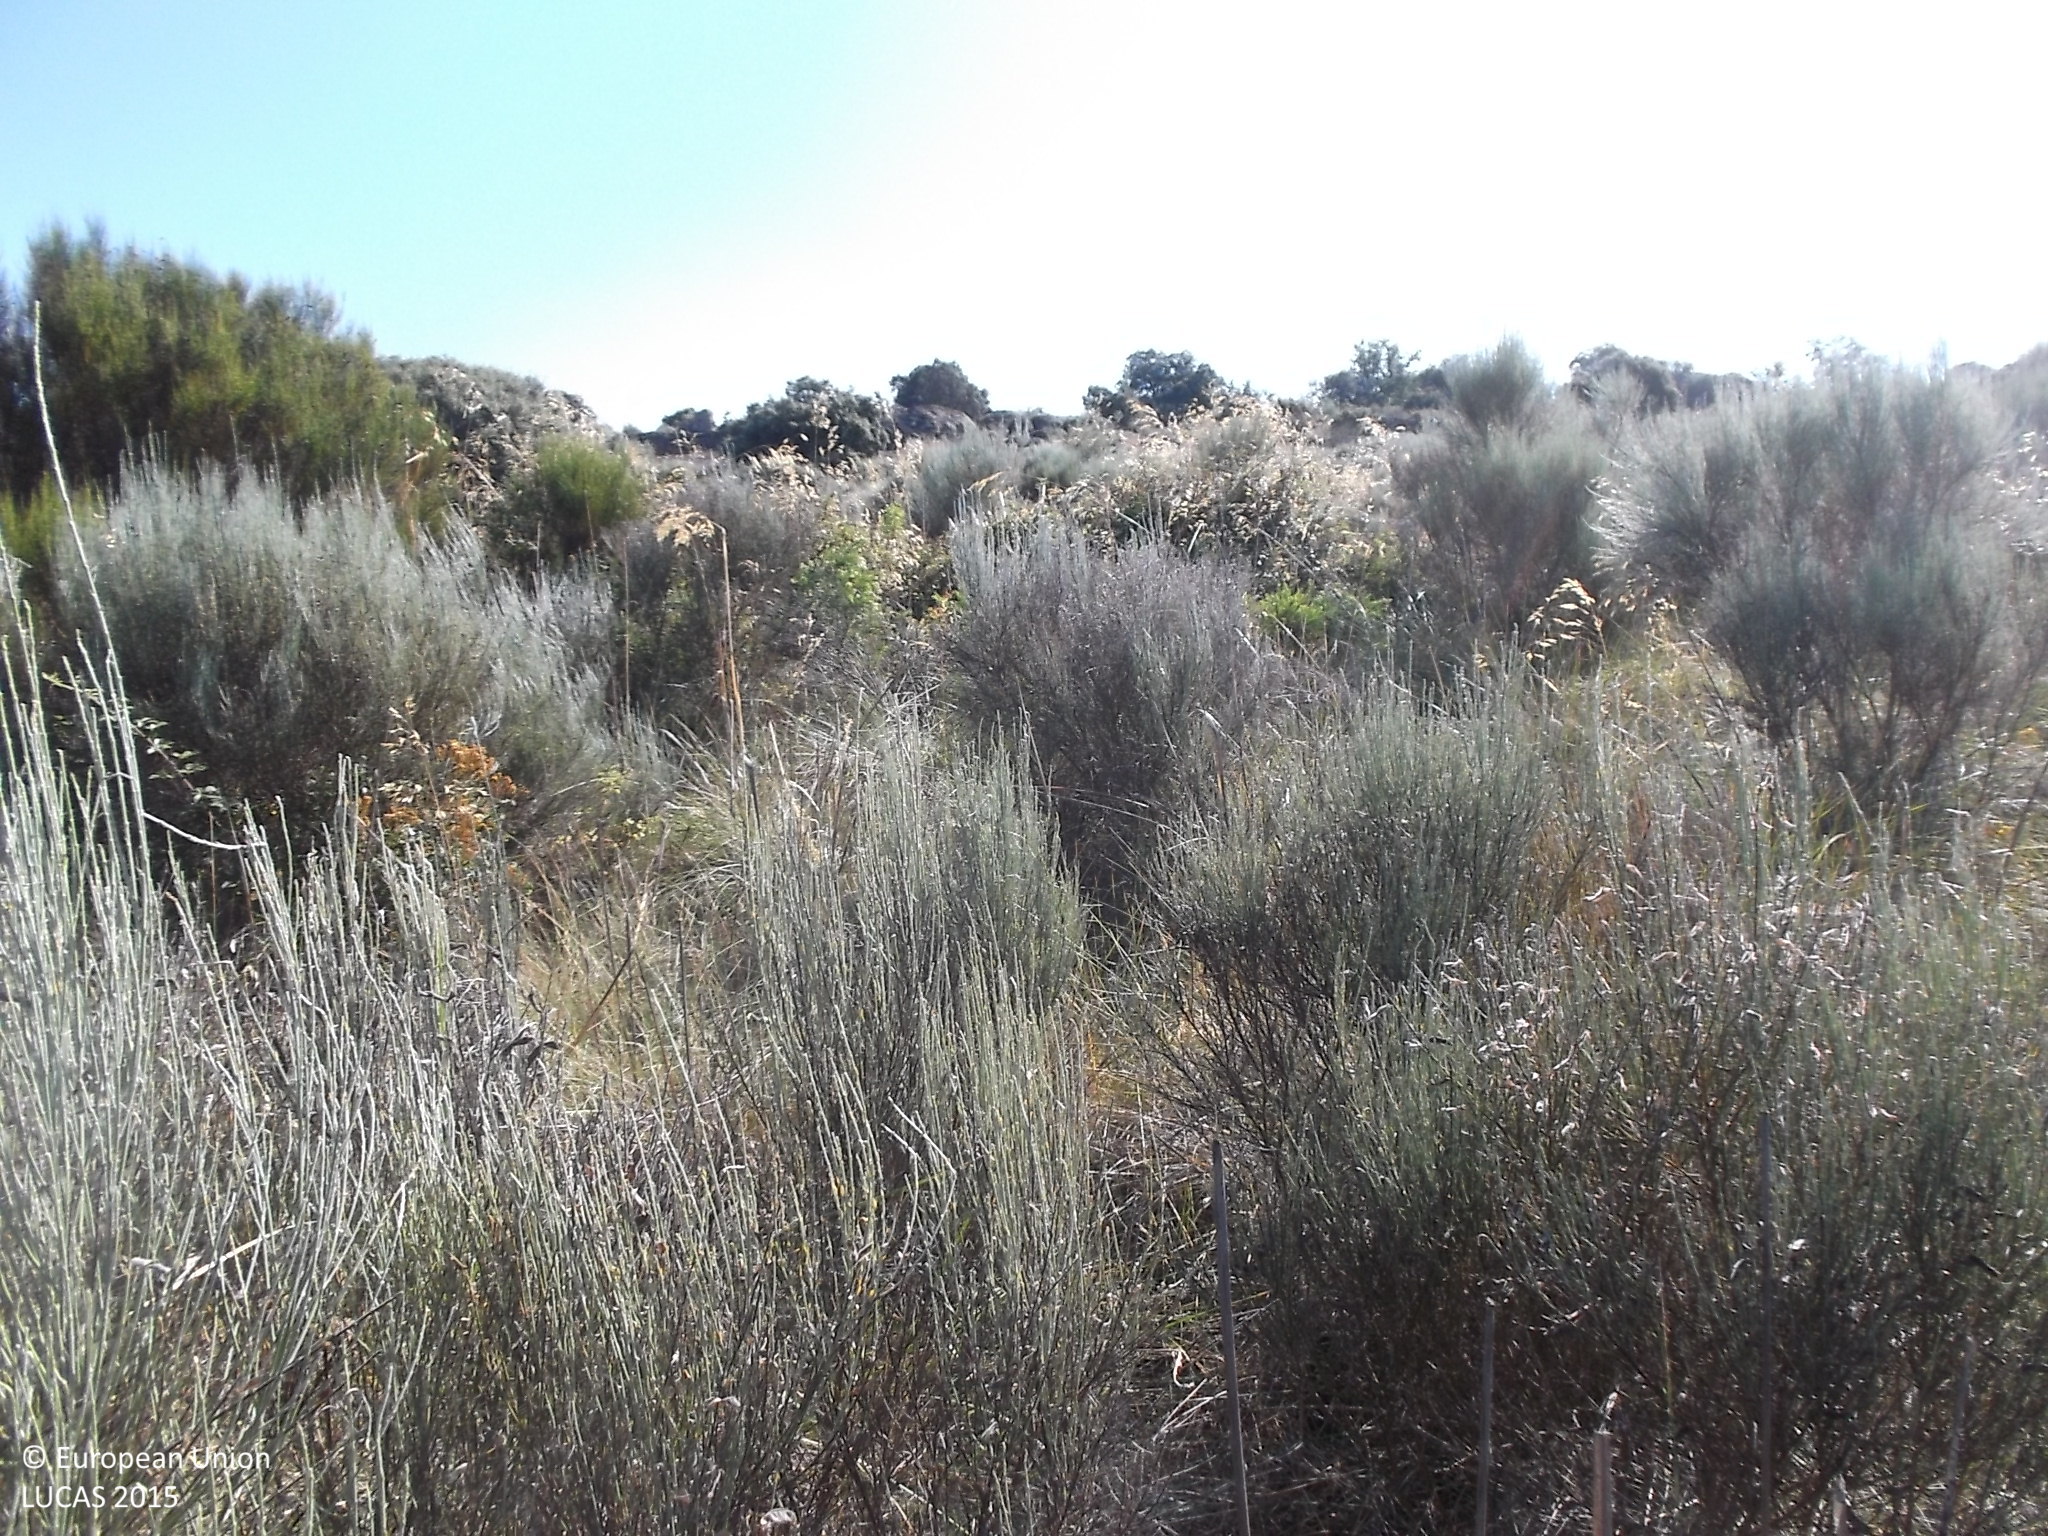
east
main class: Shrubland
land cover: Shrubland without tree cover
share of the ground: > 75 %
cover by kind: shrubs 100 %
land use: Semi-natural and natural areas not in use
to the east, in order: Shrubland without tree cover; Shruby margins; Shrubland without tree cover; Dry stone walls; Shrubland without tree cover; Rocks and stones; Grassland with sparse tree/shrub cover; Rocks and stones; Dry stone walls; Rocks and stones
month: July
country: ES
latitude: 41.2125
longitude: -6.5223
